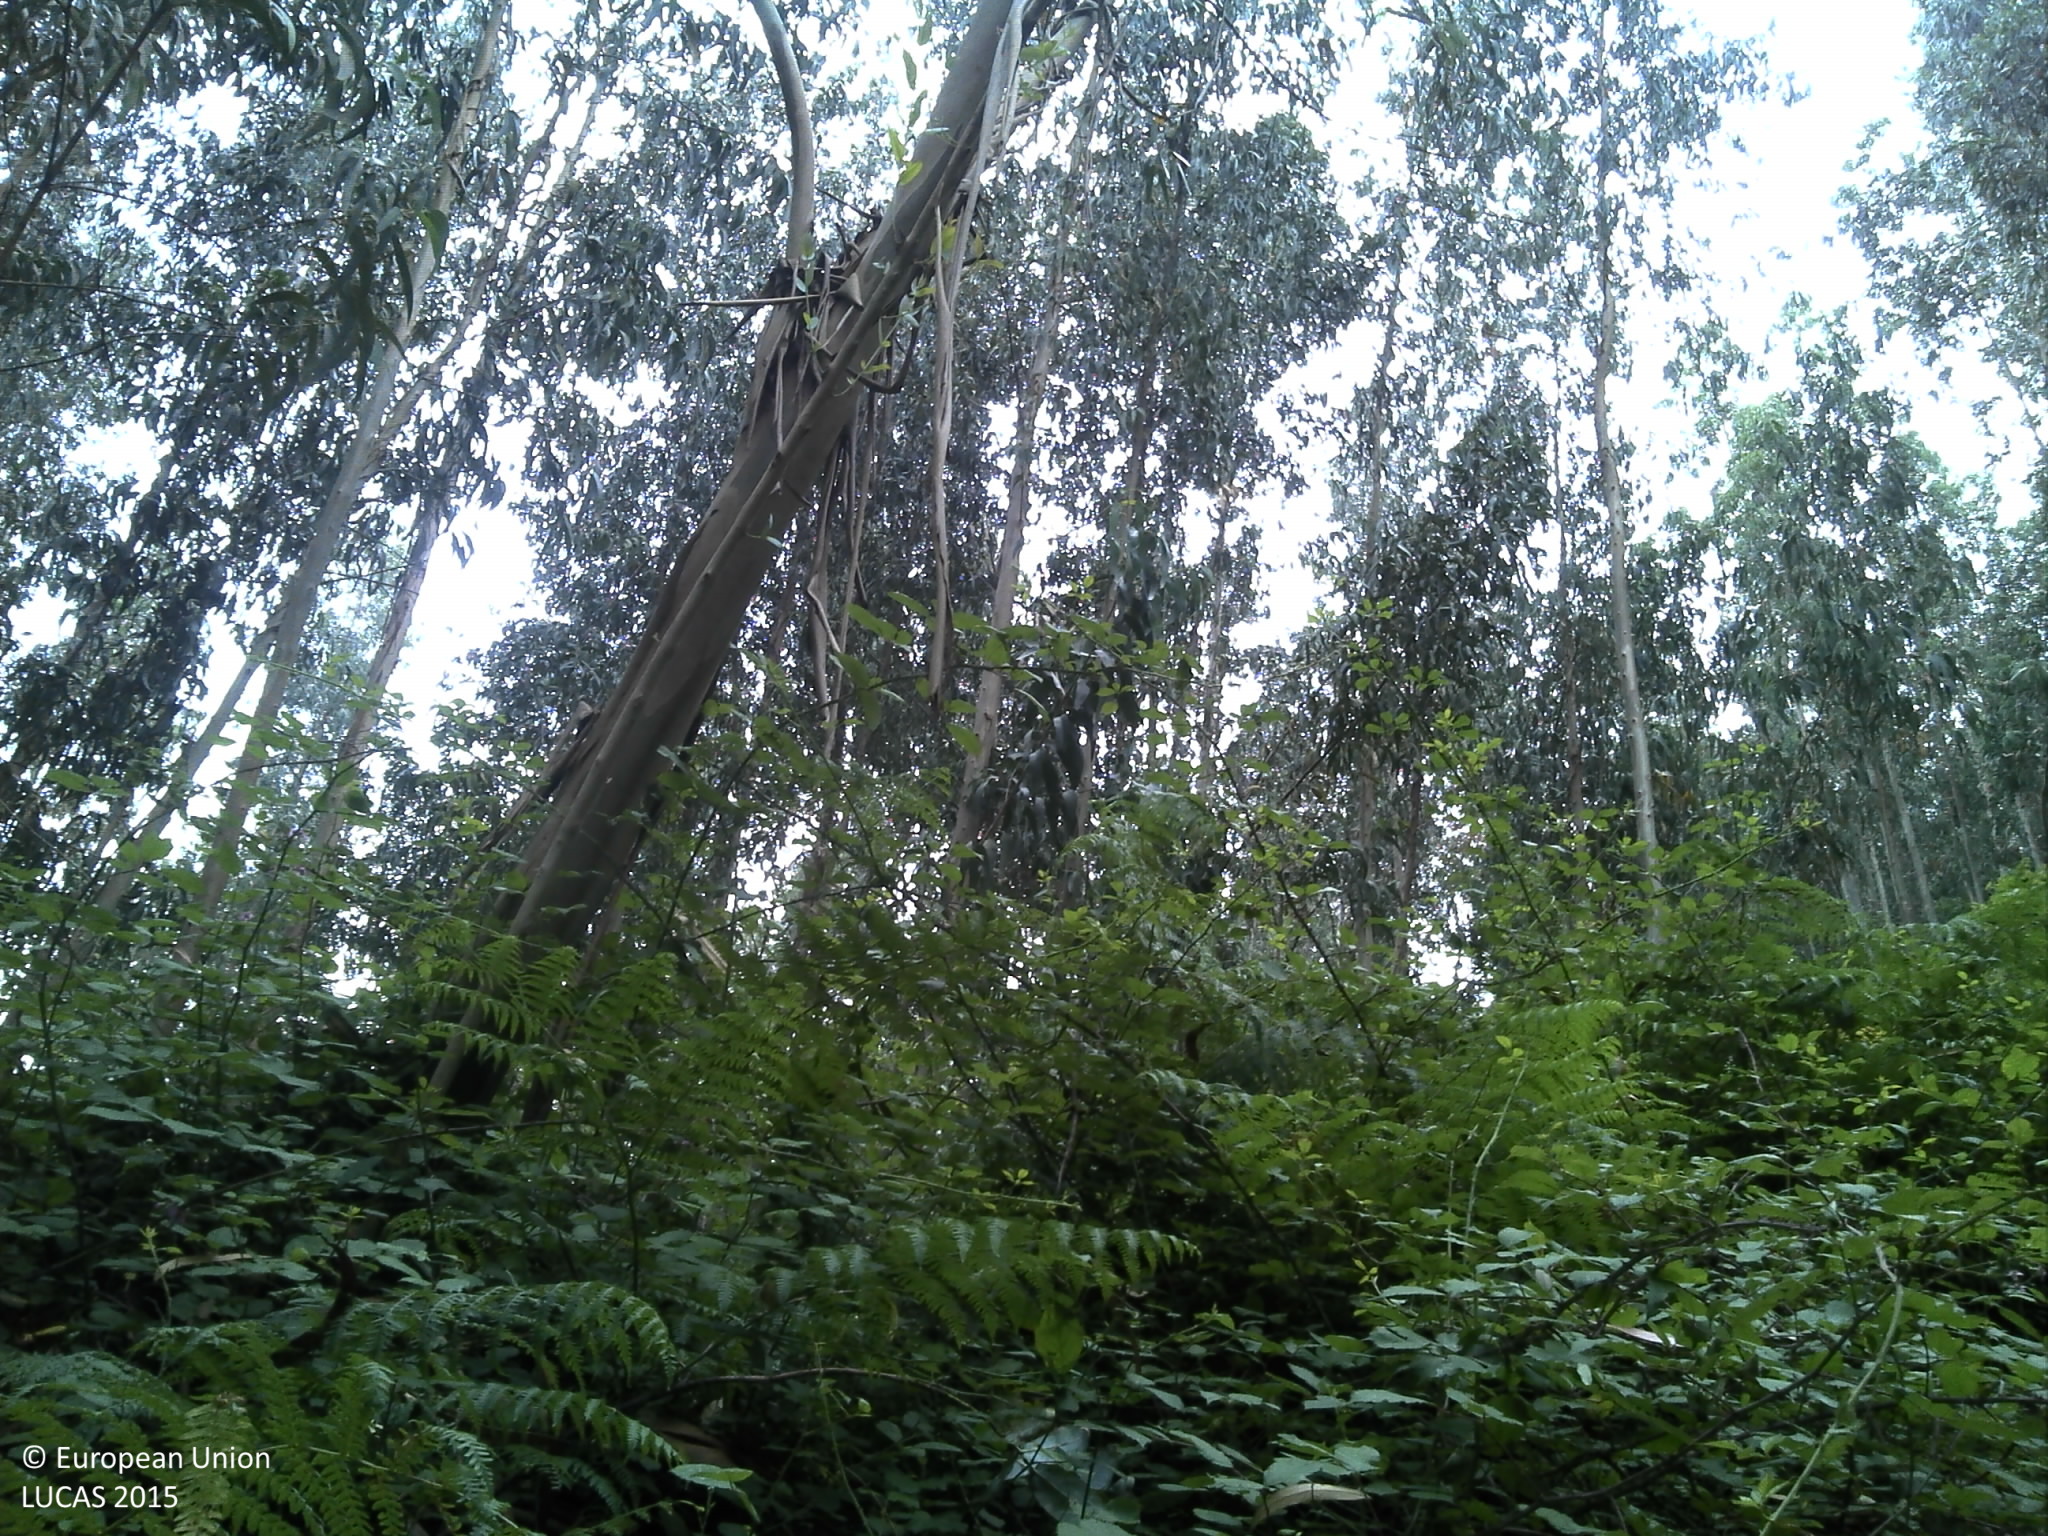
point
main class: Woodland
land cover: Broadleaved woodland
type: exotic forest
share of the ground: 50 - 75 %
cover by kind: broadleaved forest trees 70 %, shrubs 25 %, unconsolidated bare surface 5 %
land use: Forestry
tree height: > 5 m
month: June
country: PT
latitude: 40.3471
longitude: -8.3679
